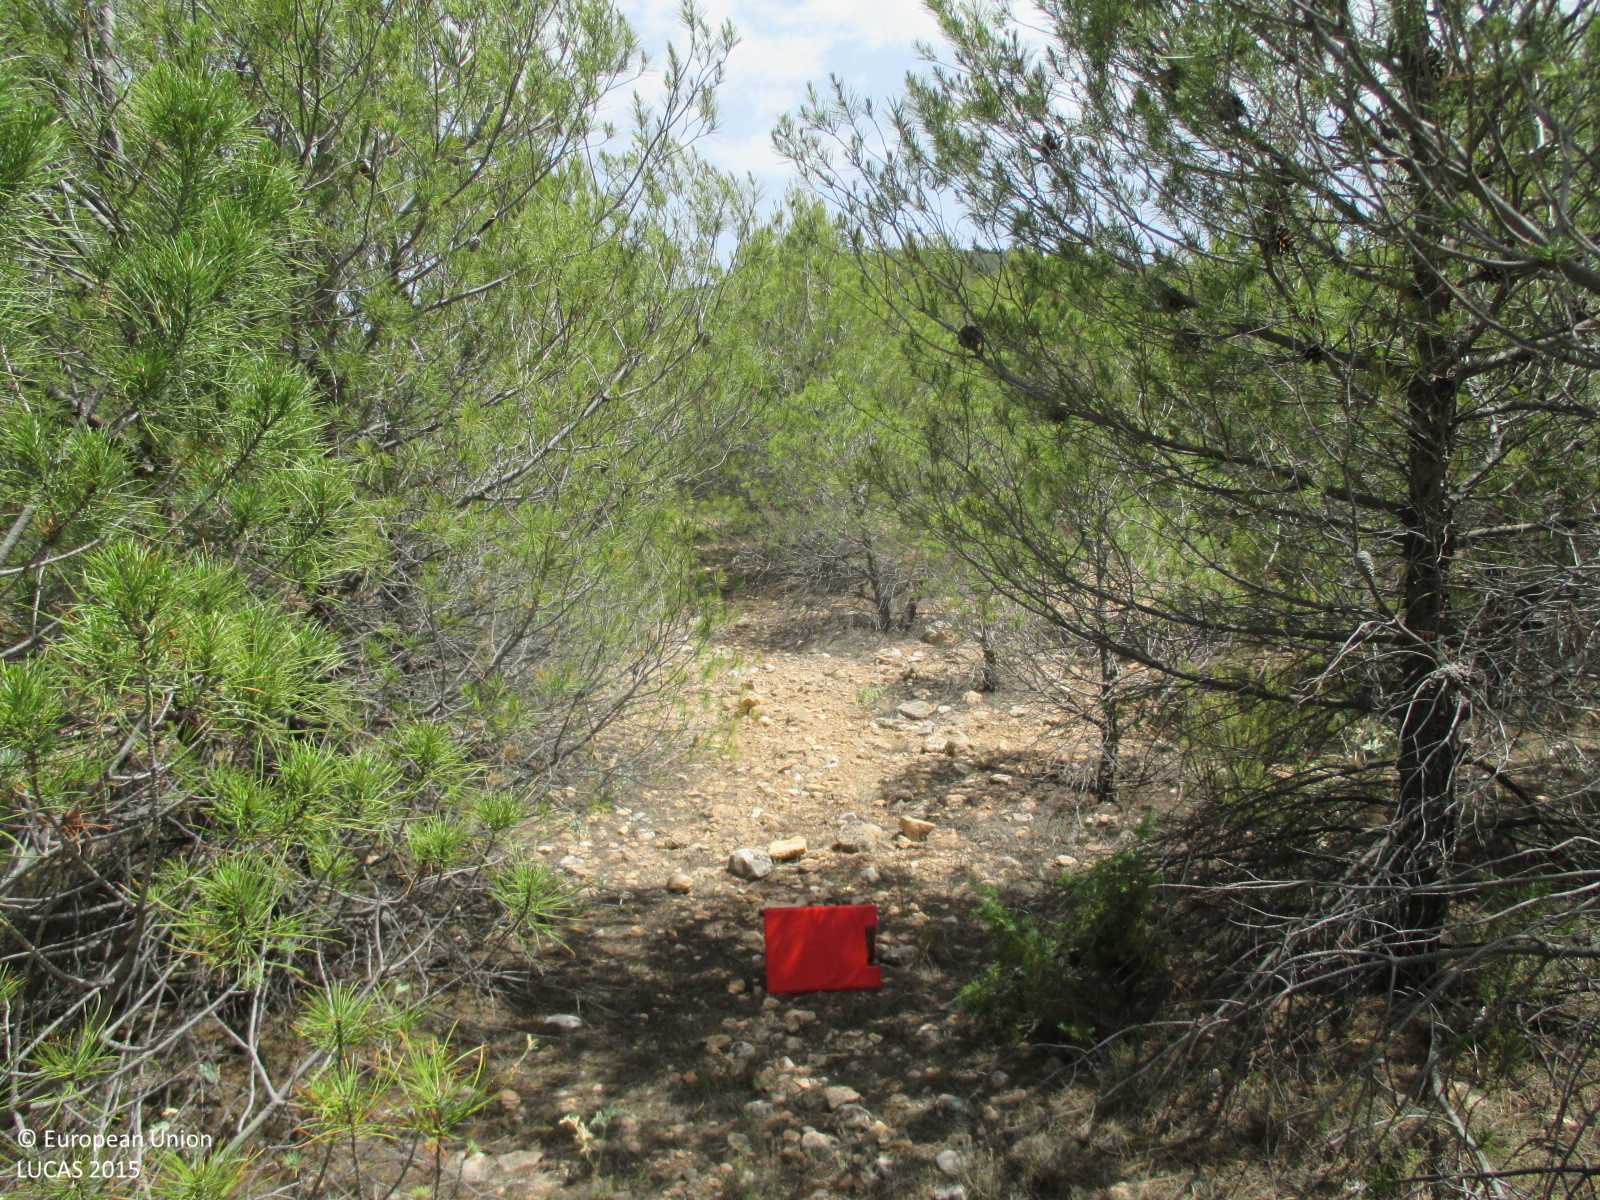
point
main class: Woodland
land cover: Pine dominated coniferous woodland
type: coniferous forest of the mediterranean region
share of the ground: > 75 %
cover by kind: coniferous forest trees 90 %, unconsolidated bare surface 10 %
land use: Forestry
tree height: < 5 m
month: June
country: ES
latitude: 37.6655
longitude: -2.4004
